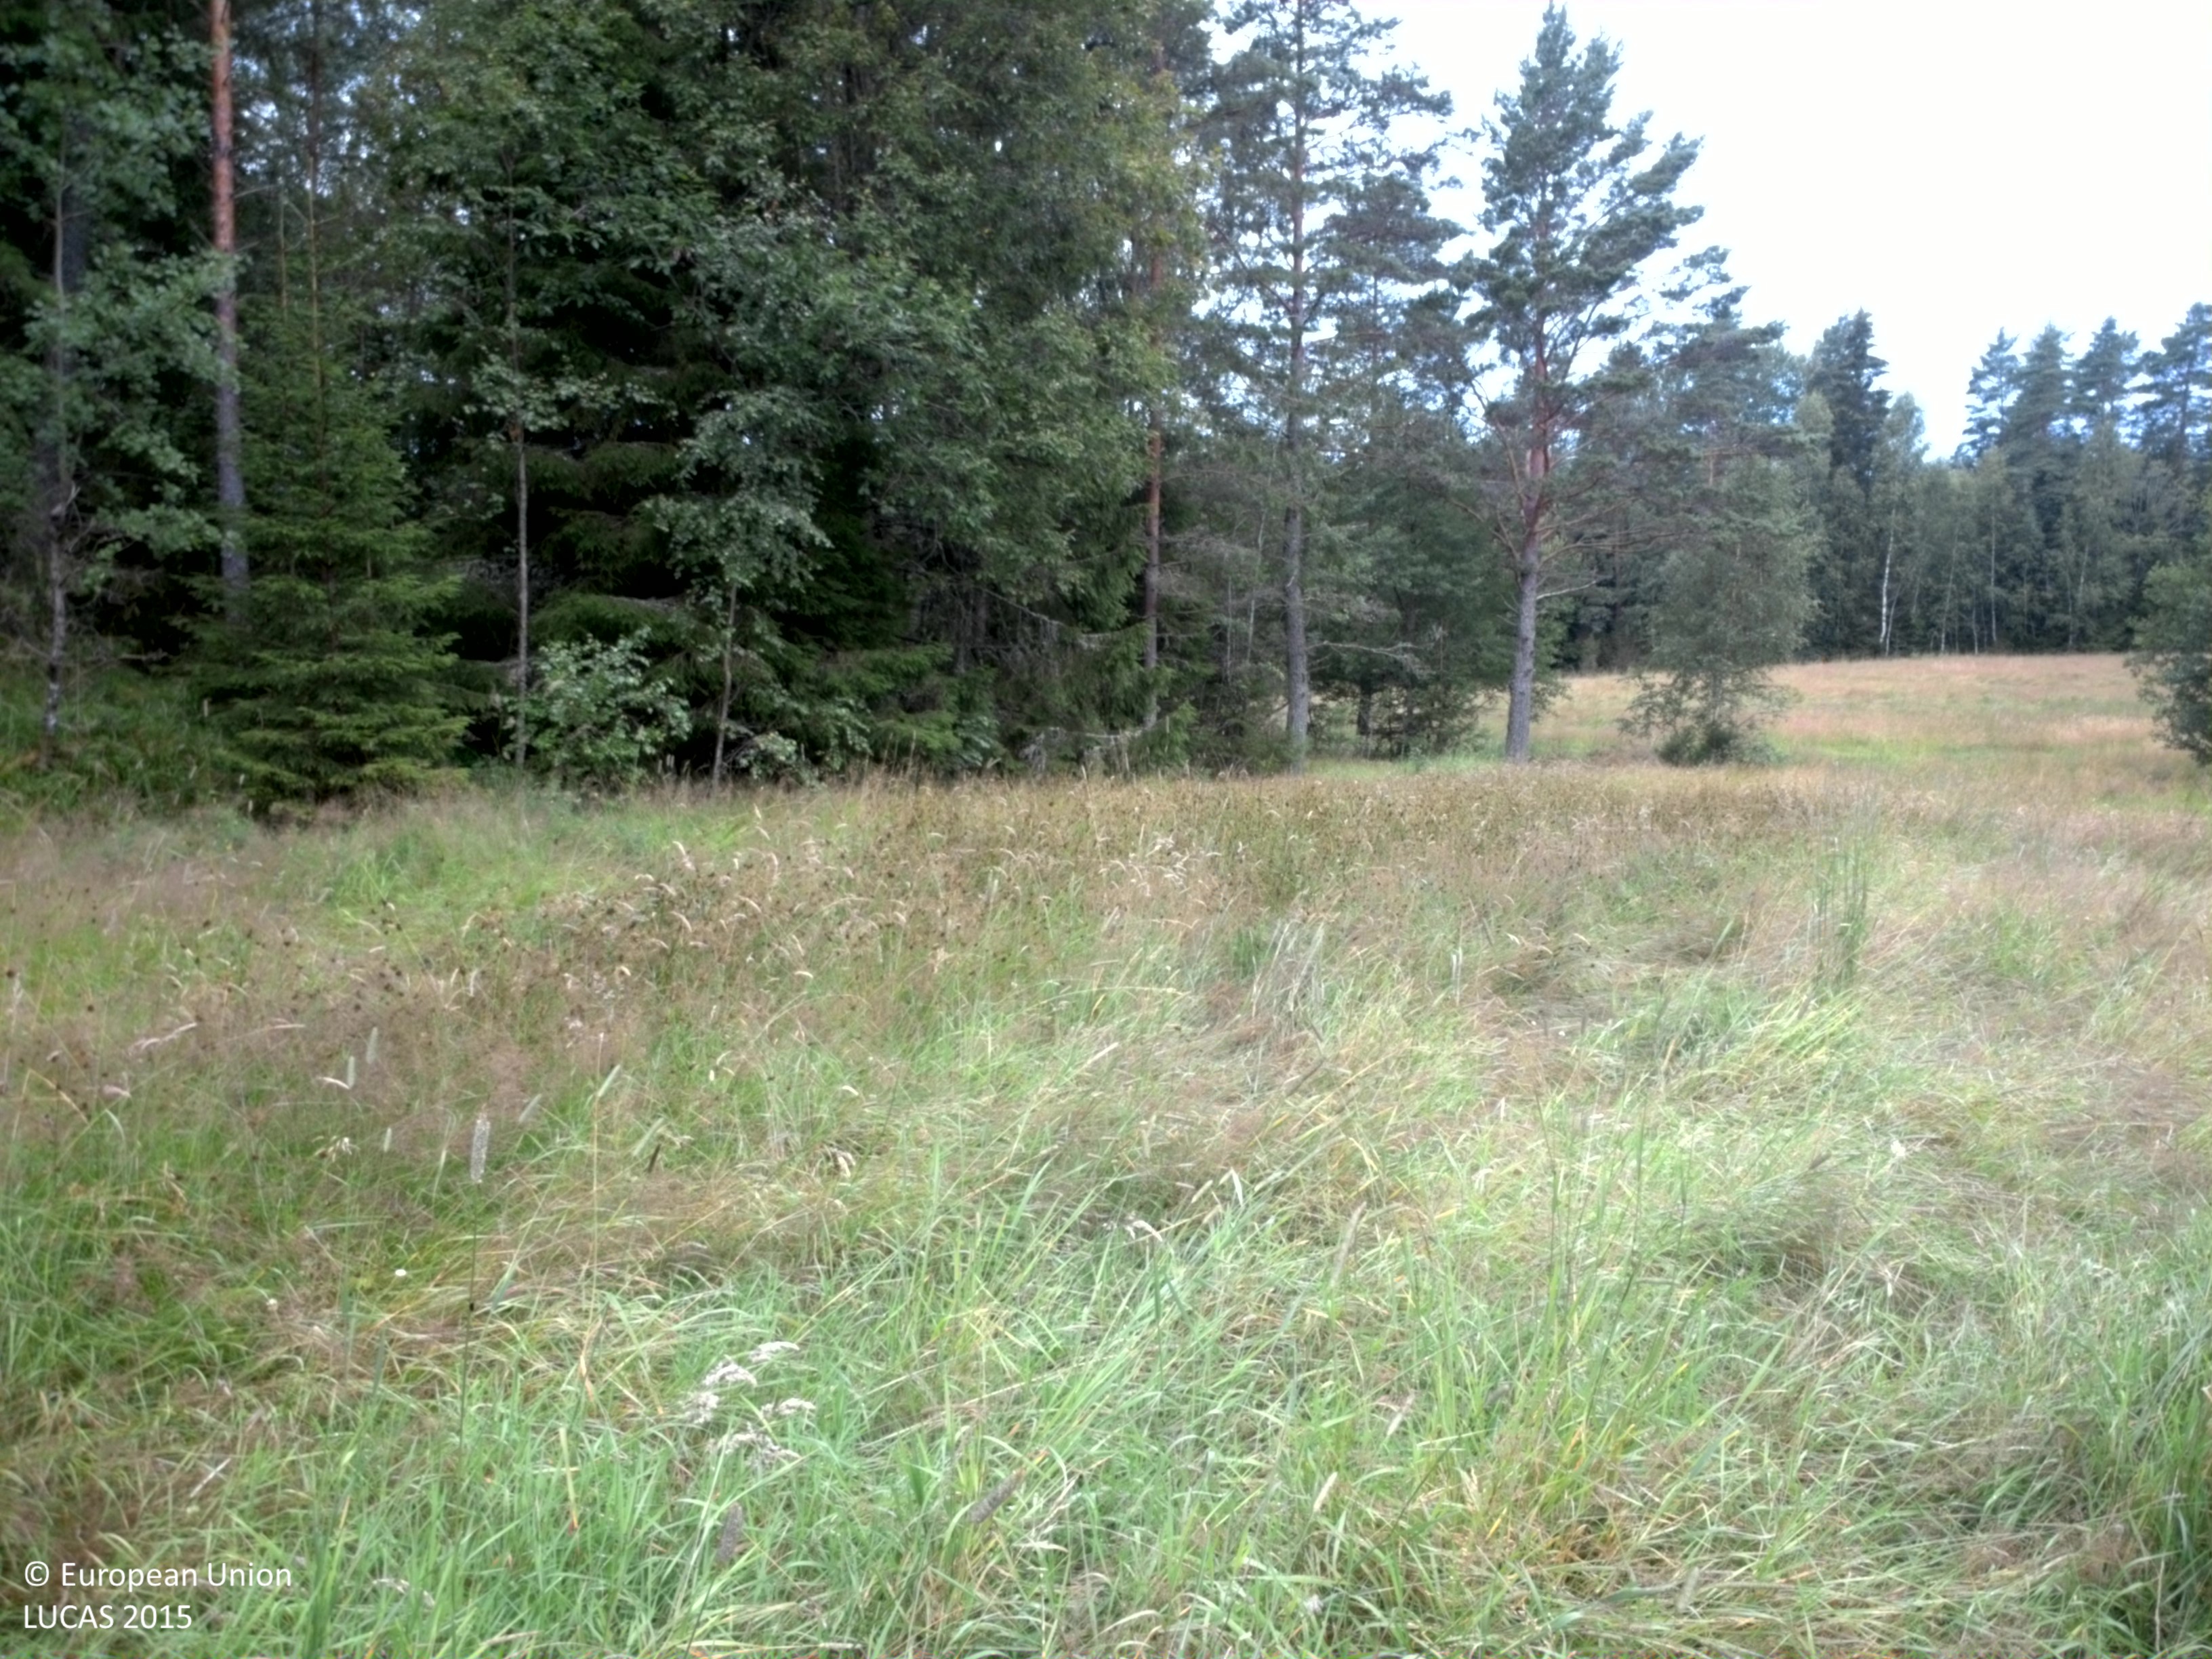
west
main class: Cropland
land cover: Temporary grasslands
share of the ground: > 75 %
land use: Agriculture (excluding fallow land and kitchen gardens)
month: August
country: SE
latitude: 59.3216
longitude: 11.9104
